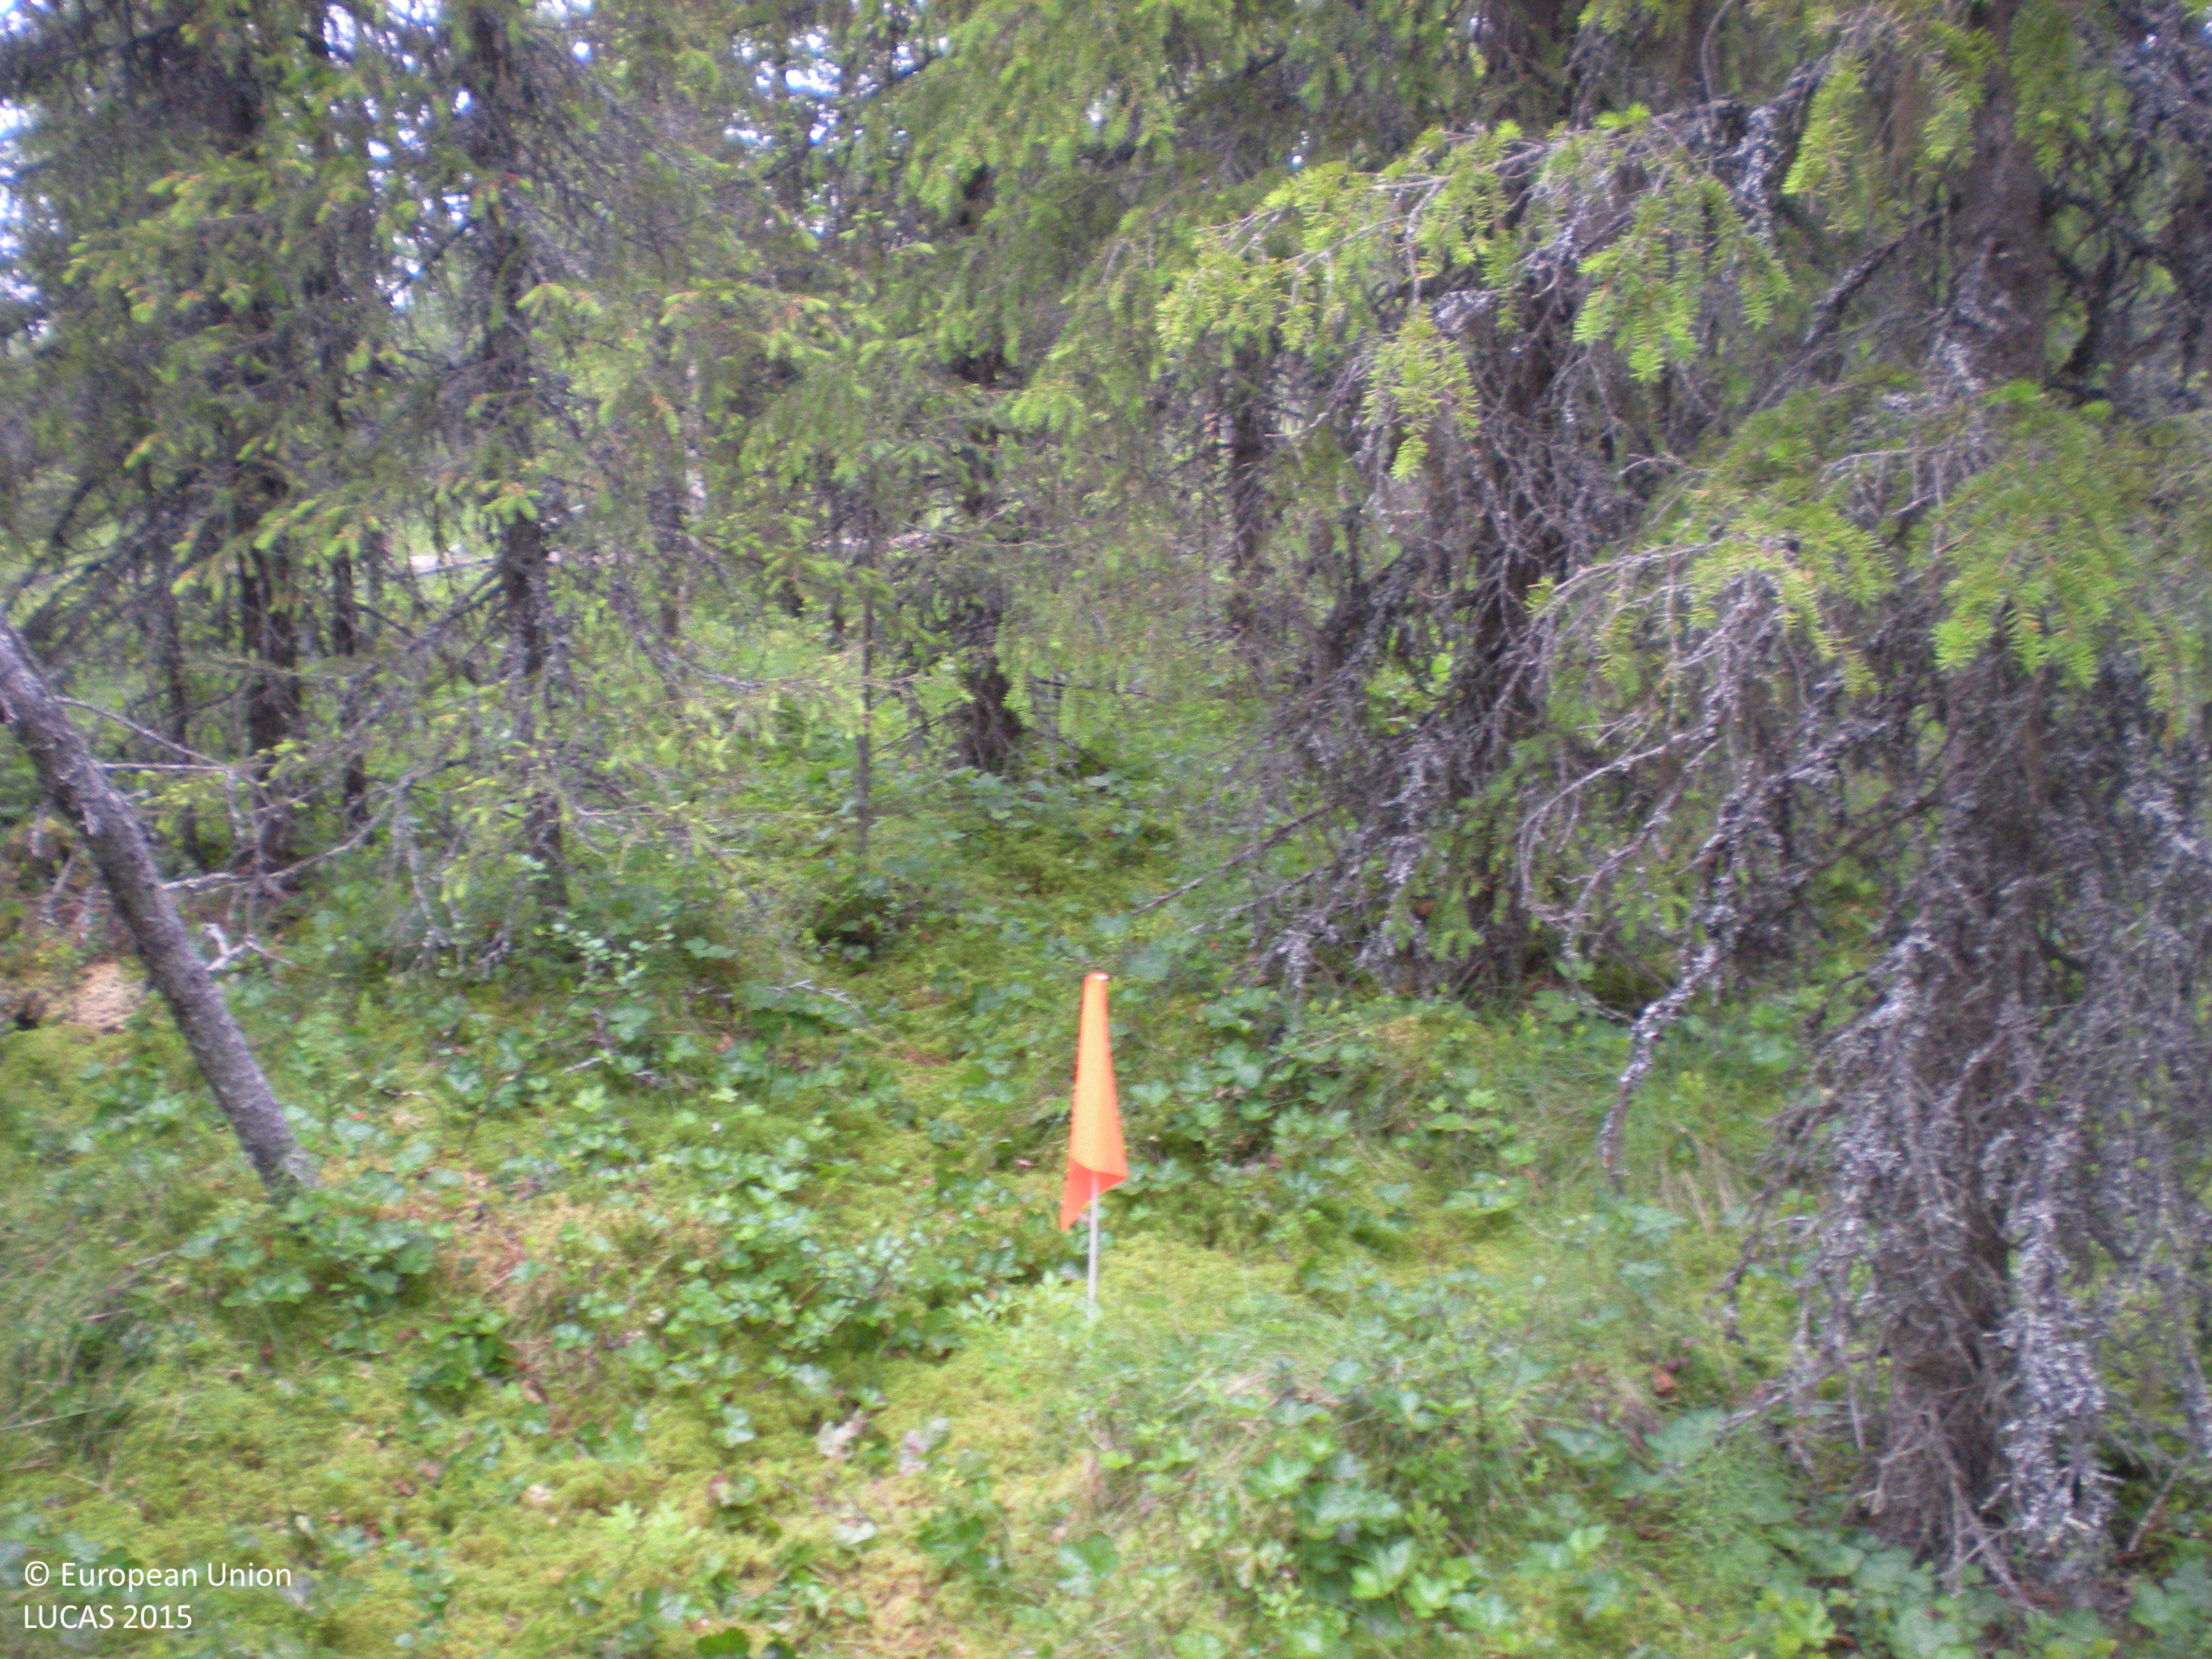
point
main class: Woodland
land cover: Spruce dominated coniferous woodland
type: boreal forest
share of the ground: > 75 %
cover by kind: coniferous forest trees 75 %, lichens and mosses 15 %, herbaceous plants 10 %
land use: Forestry
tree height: > 5 m
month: July
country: SE
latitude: 65.5237
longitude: 17.9845
